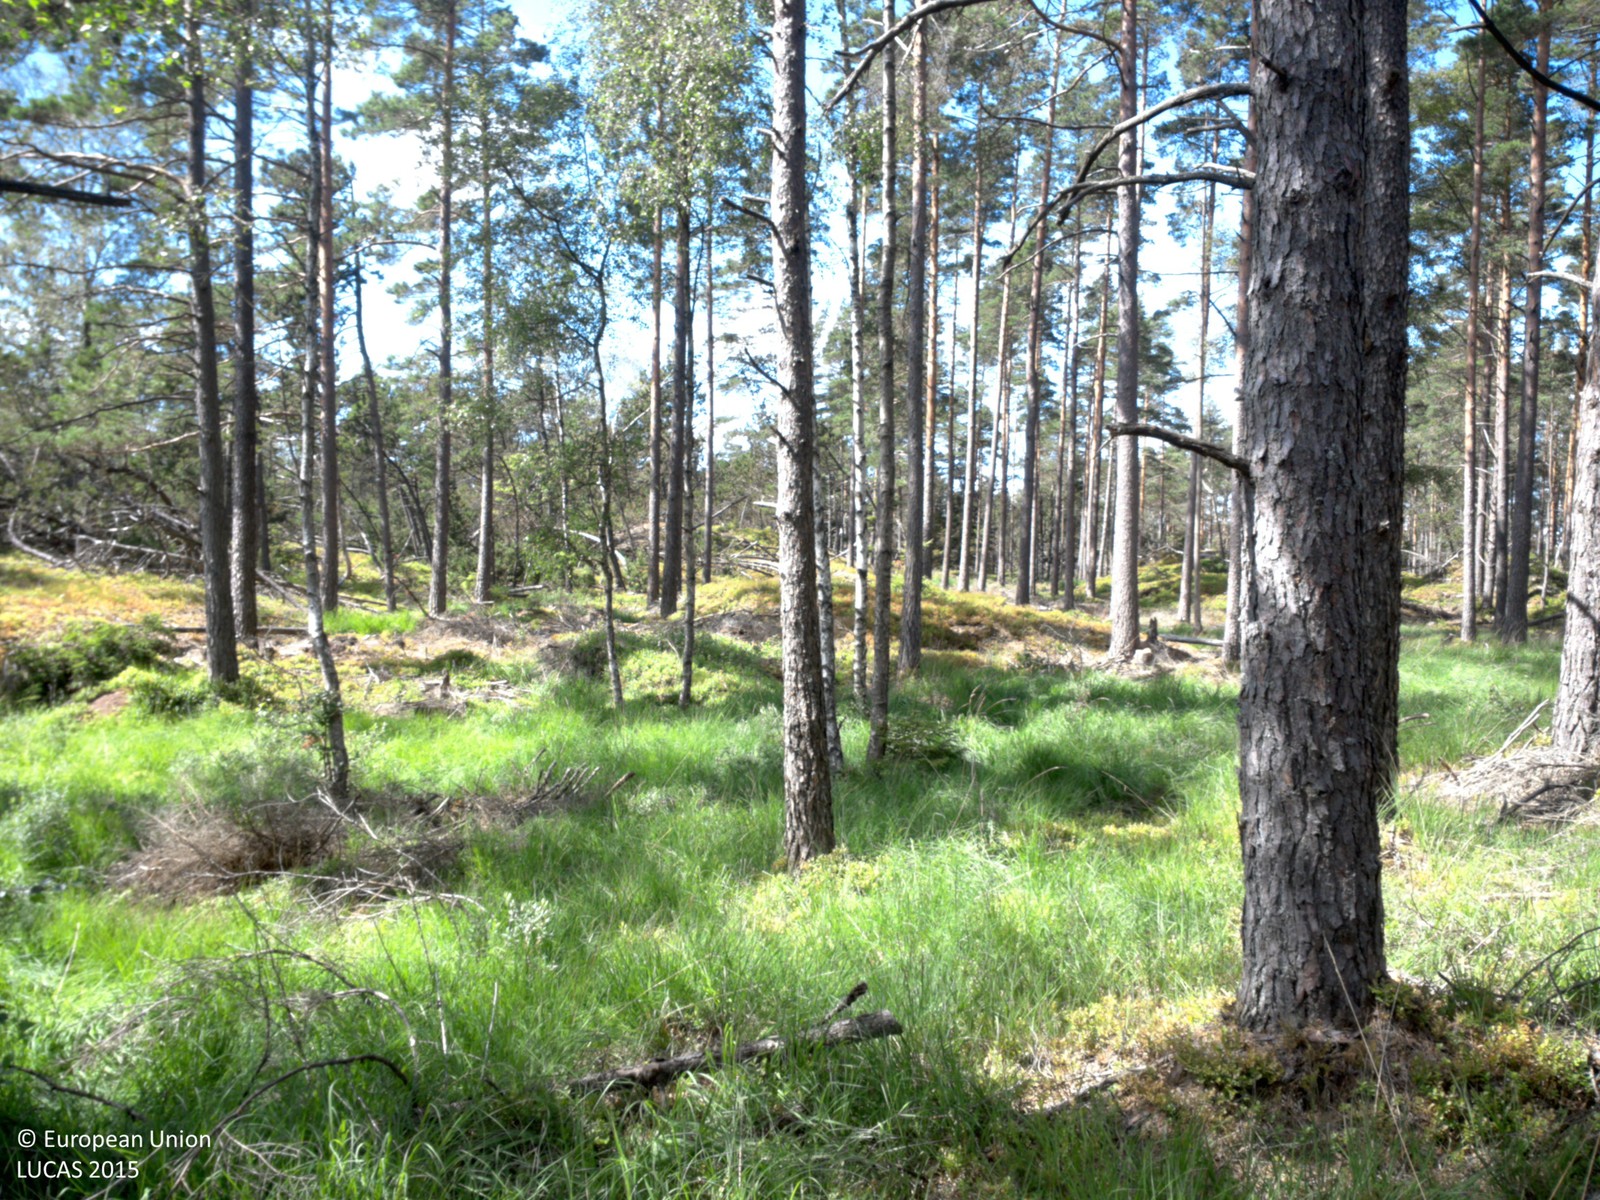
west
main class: Woodland
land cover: Pine dominated coniferous woodland
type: boreal forest
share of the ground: 50 - 75 %
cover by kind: coniferous forest trees 45 %, shrubs 25 %, lichens and mosses 25 %, broadleaved forest trees 5 %
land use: Forestry
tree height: > 5 m
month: July
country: SE
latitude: 58.5672
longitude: 11.8013
